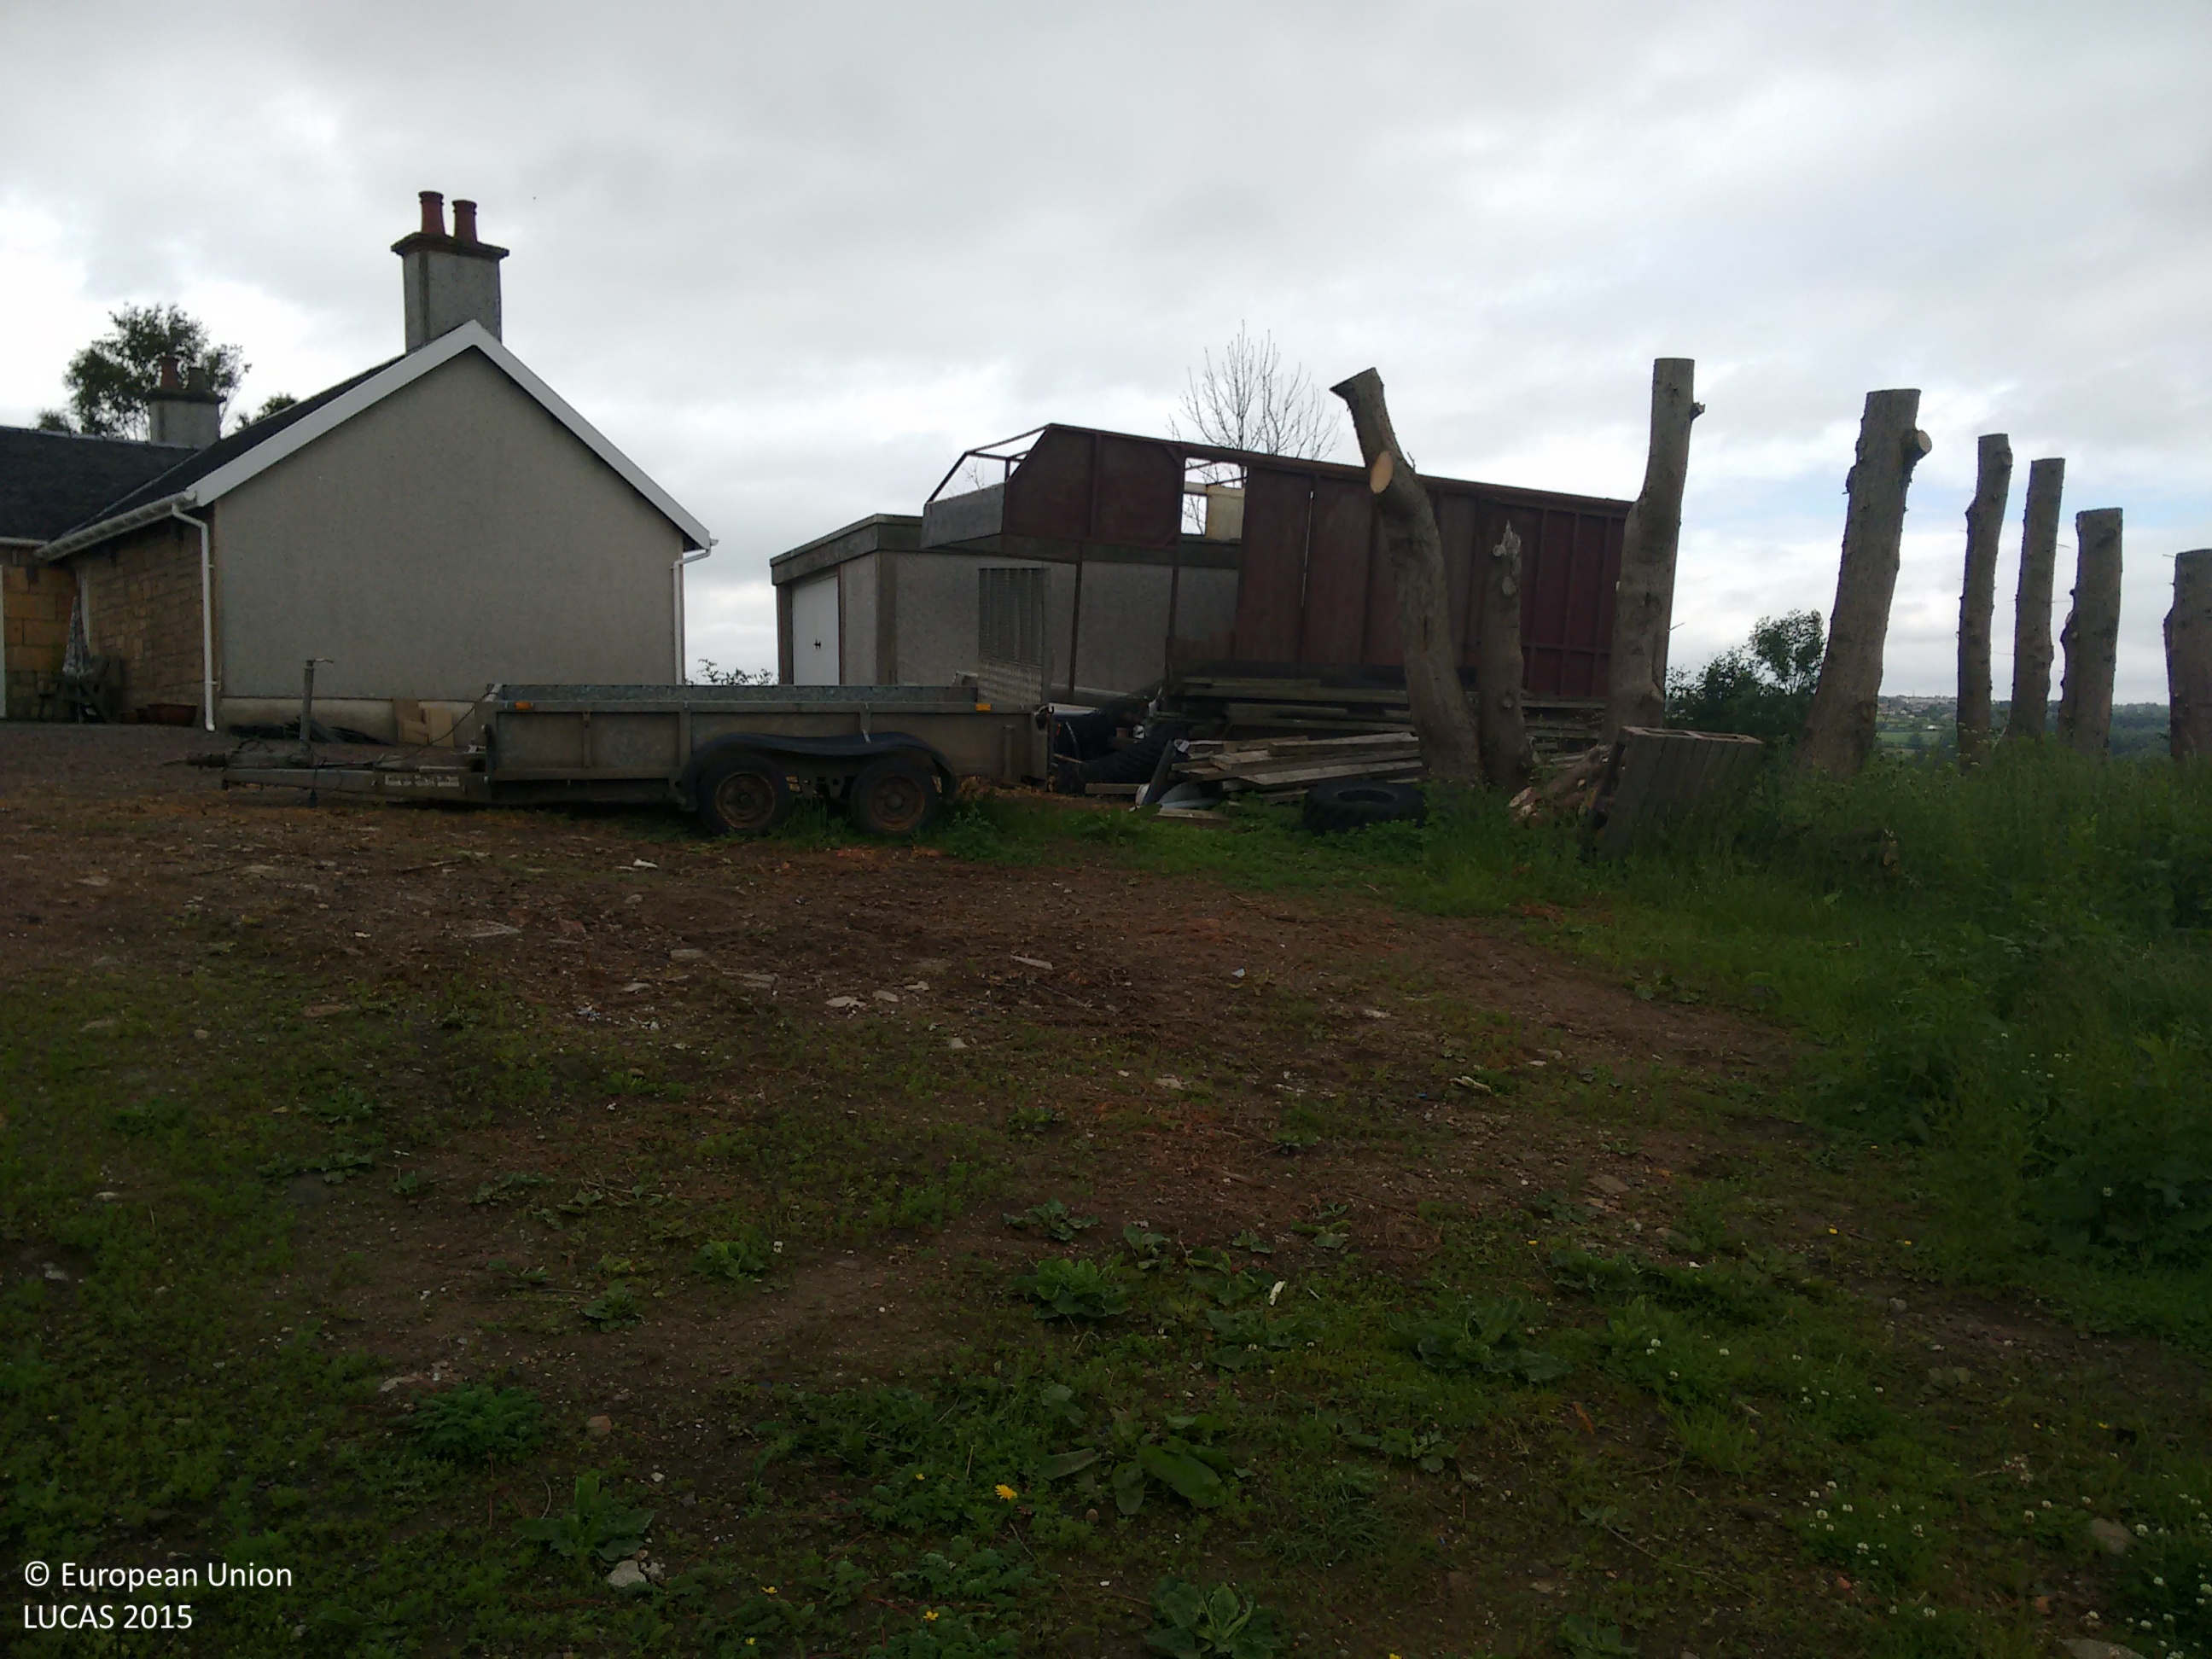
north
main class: Grassland
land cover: Spontaneously vegetated surfaces
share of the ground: 50 - 75 %
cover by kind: herbaceous plants 100 %
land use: Agriculture (excluding fallow land and kitchen gardens)
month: June
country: GB
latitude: 55.7340
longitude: -3.9259
